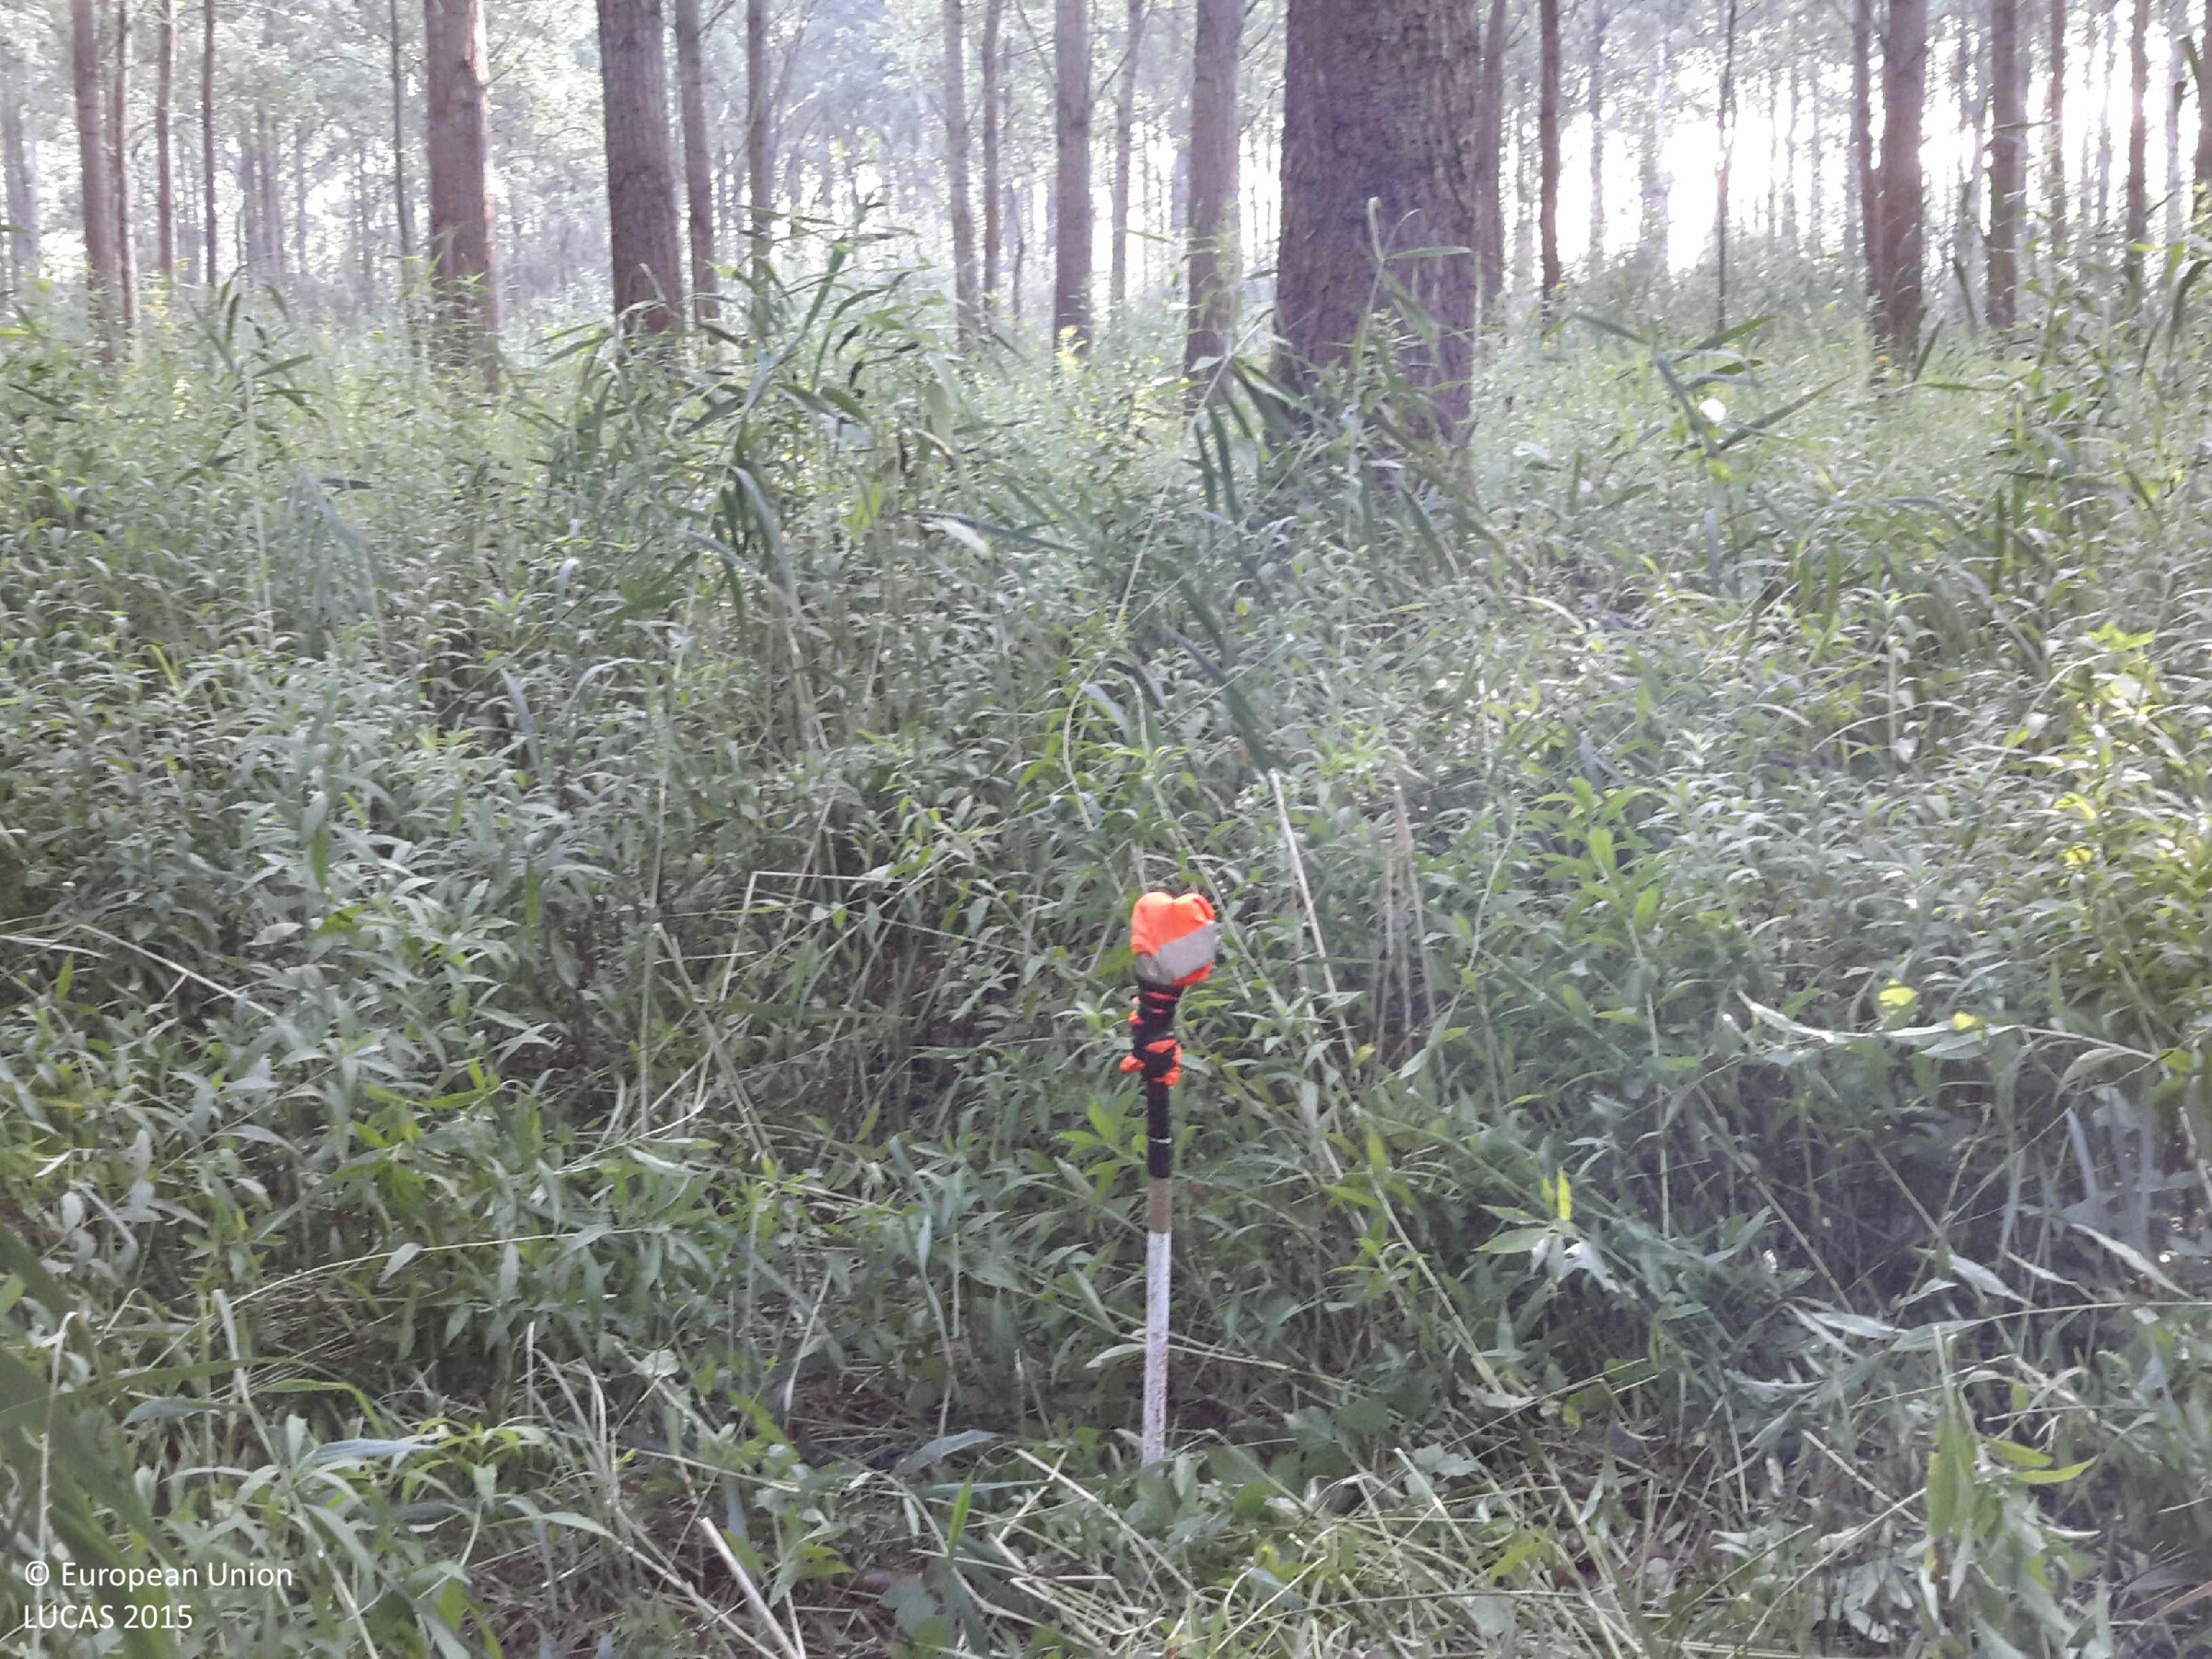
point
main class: Woodland
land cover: Broadleaved woodland
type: mesophytic deciduous forest
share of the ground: > 75 %
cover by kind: broadleaved forest trees 90 %, herbaceous plants 10 %
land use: Forestry
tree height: > 5 m
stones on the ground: < 10 %
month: August
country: HU
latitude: 47.7301
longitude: 17.2743
